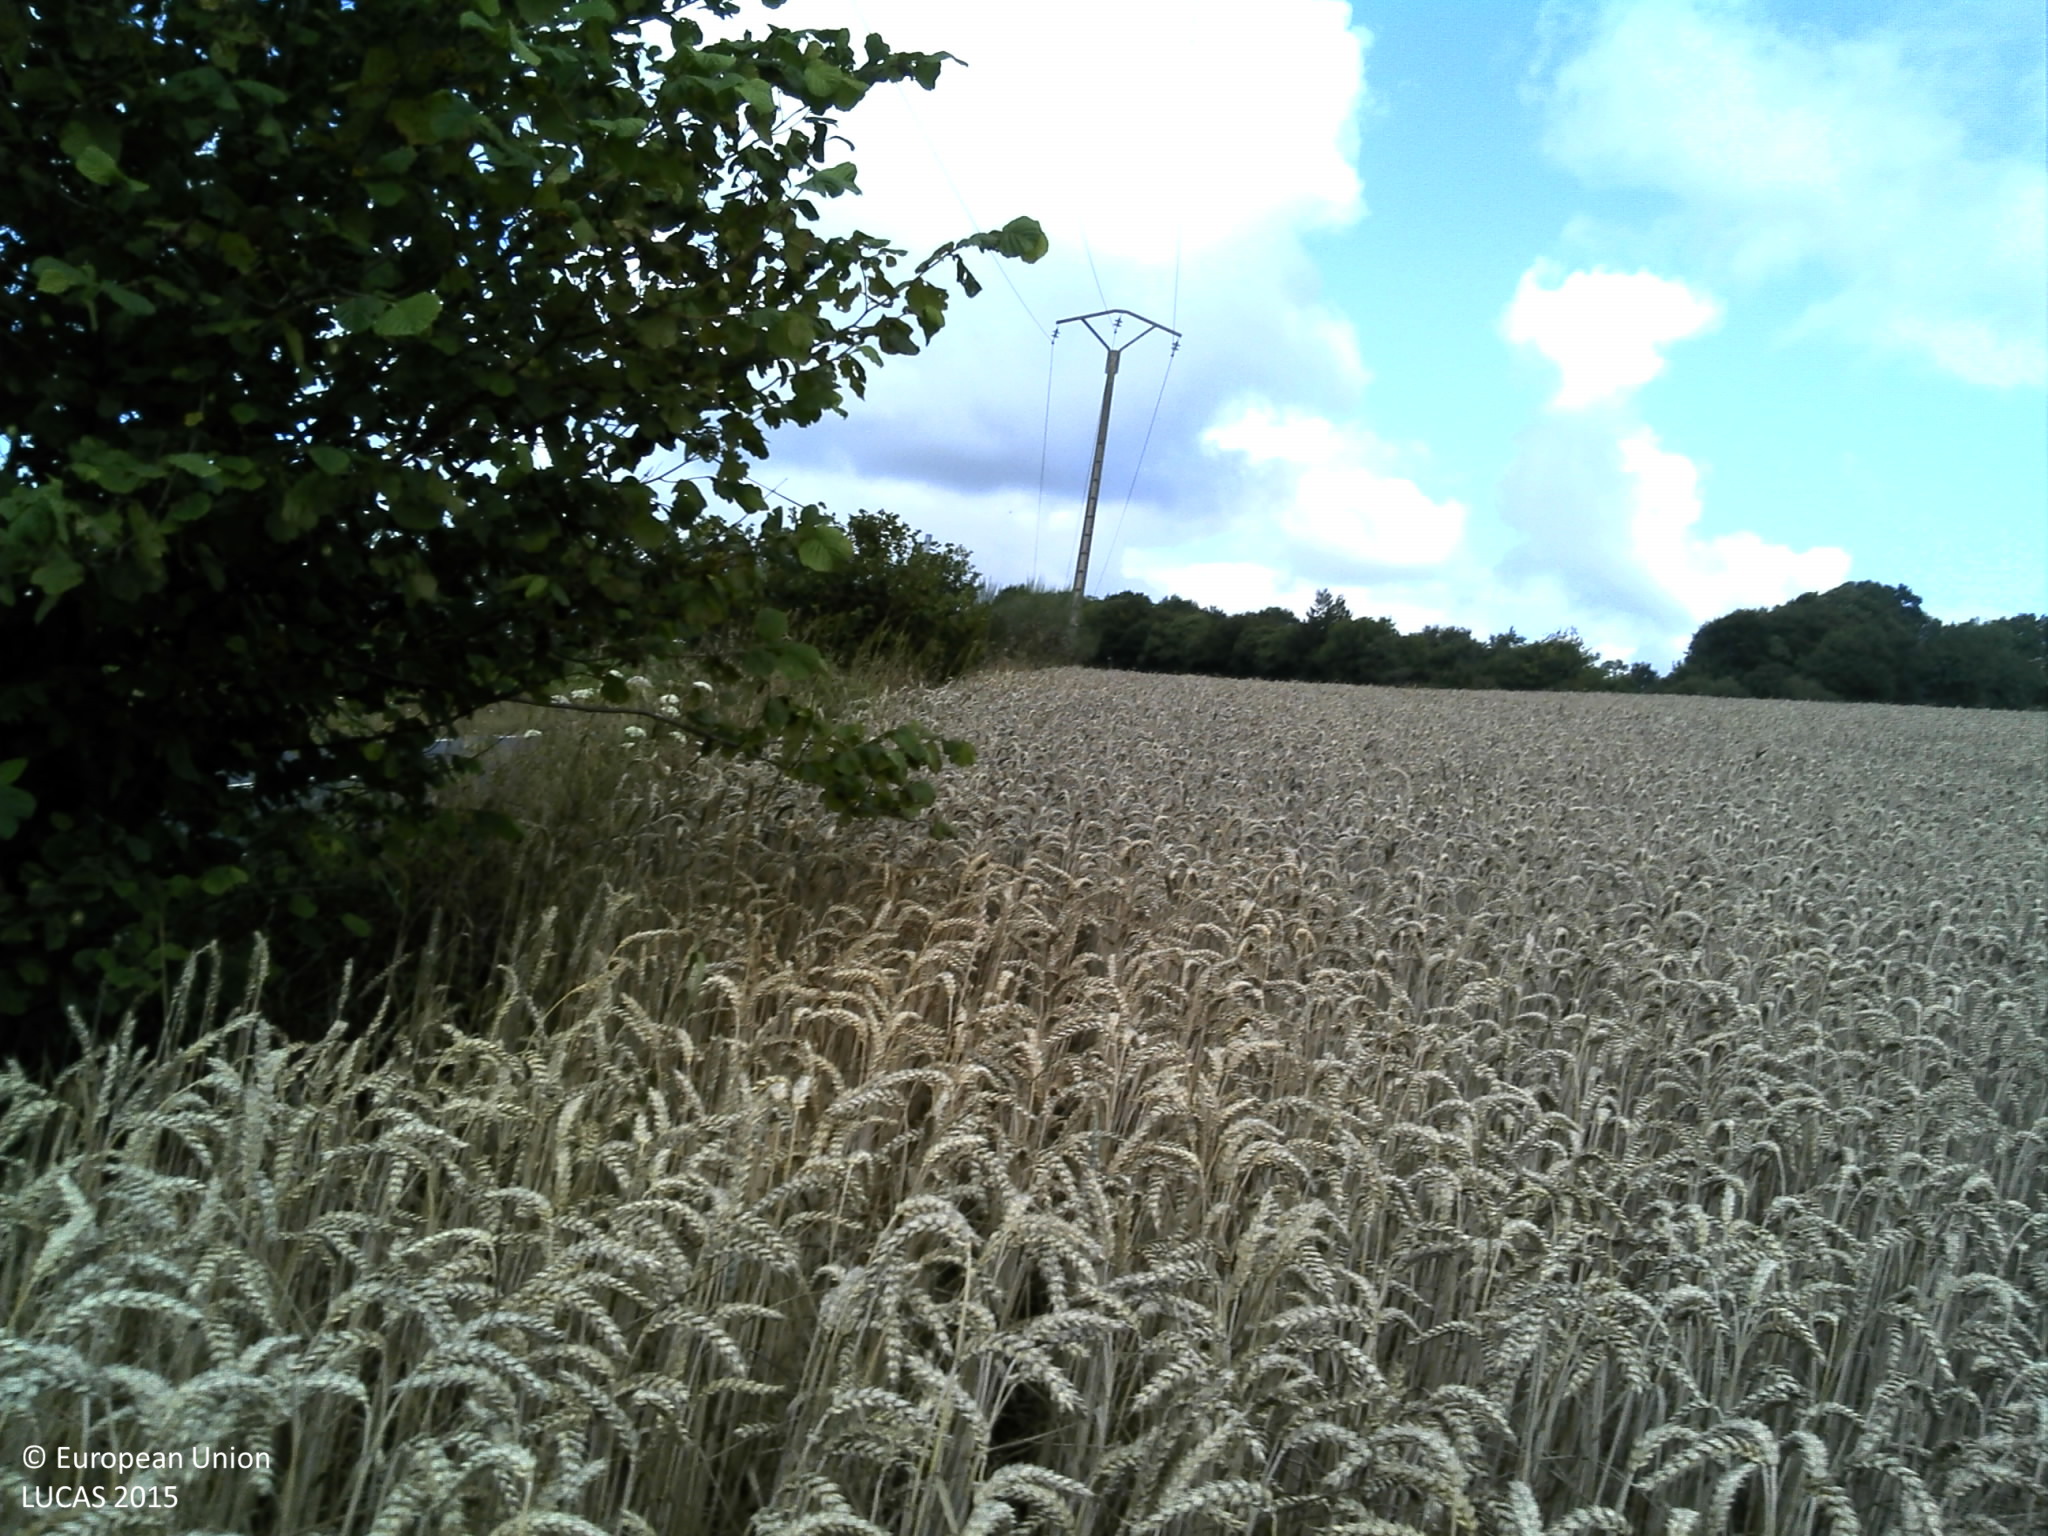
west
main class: Cropland
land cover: Common wheat
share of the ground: > 75 %
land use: Agriculture (excluding fallow land and kitchen gardens)
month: July
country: FR
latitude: 48.3456
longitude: -3.7238
